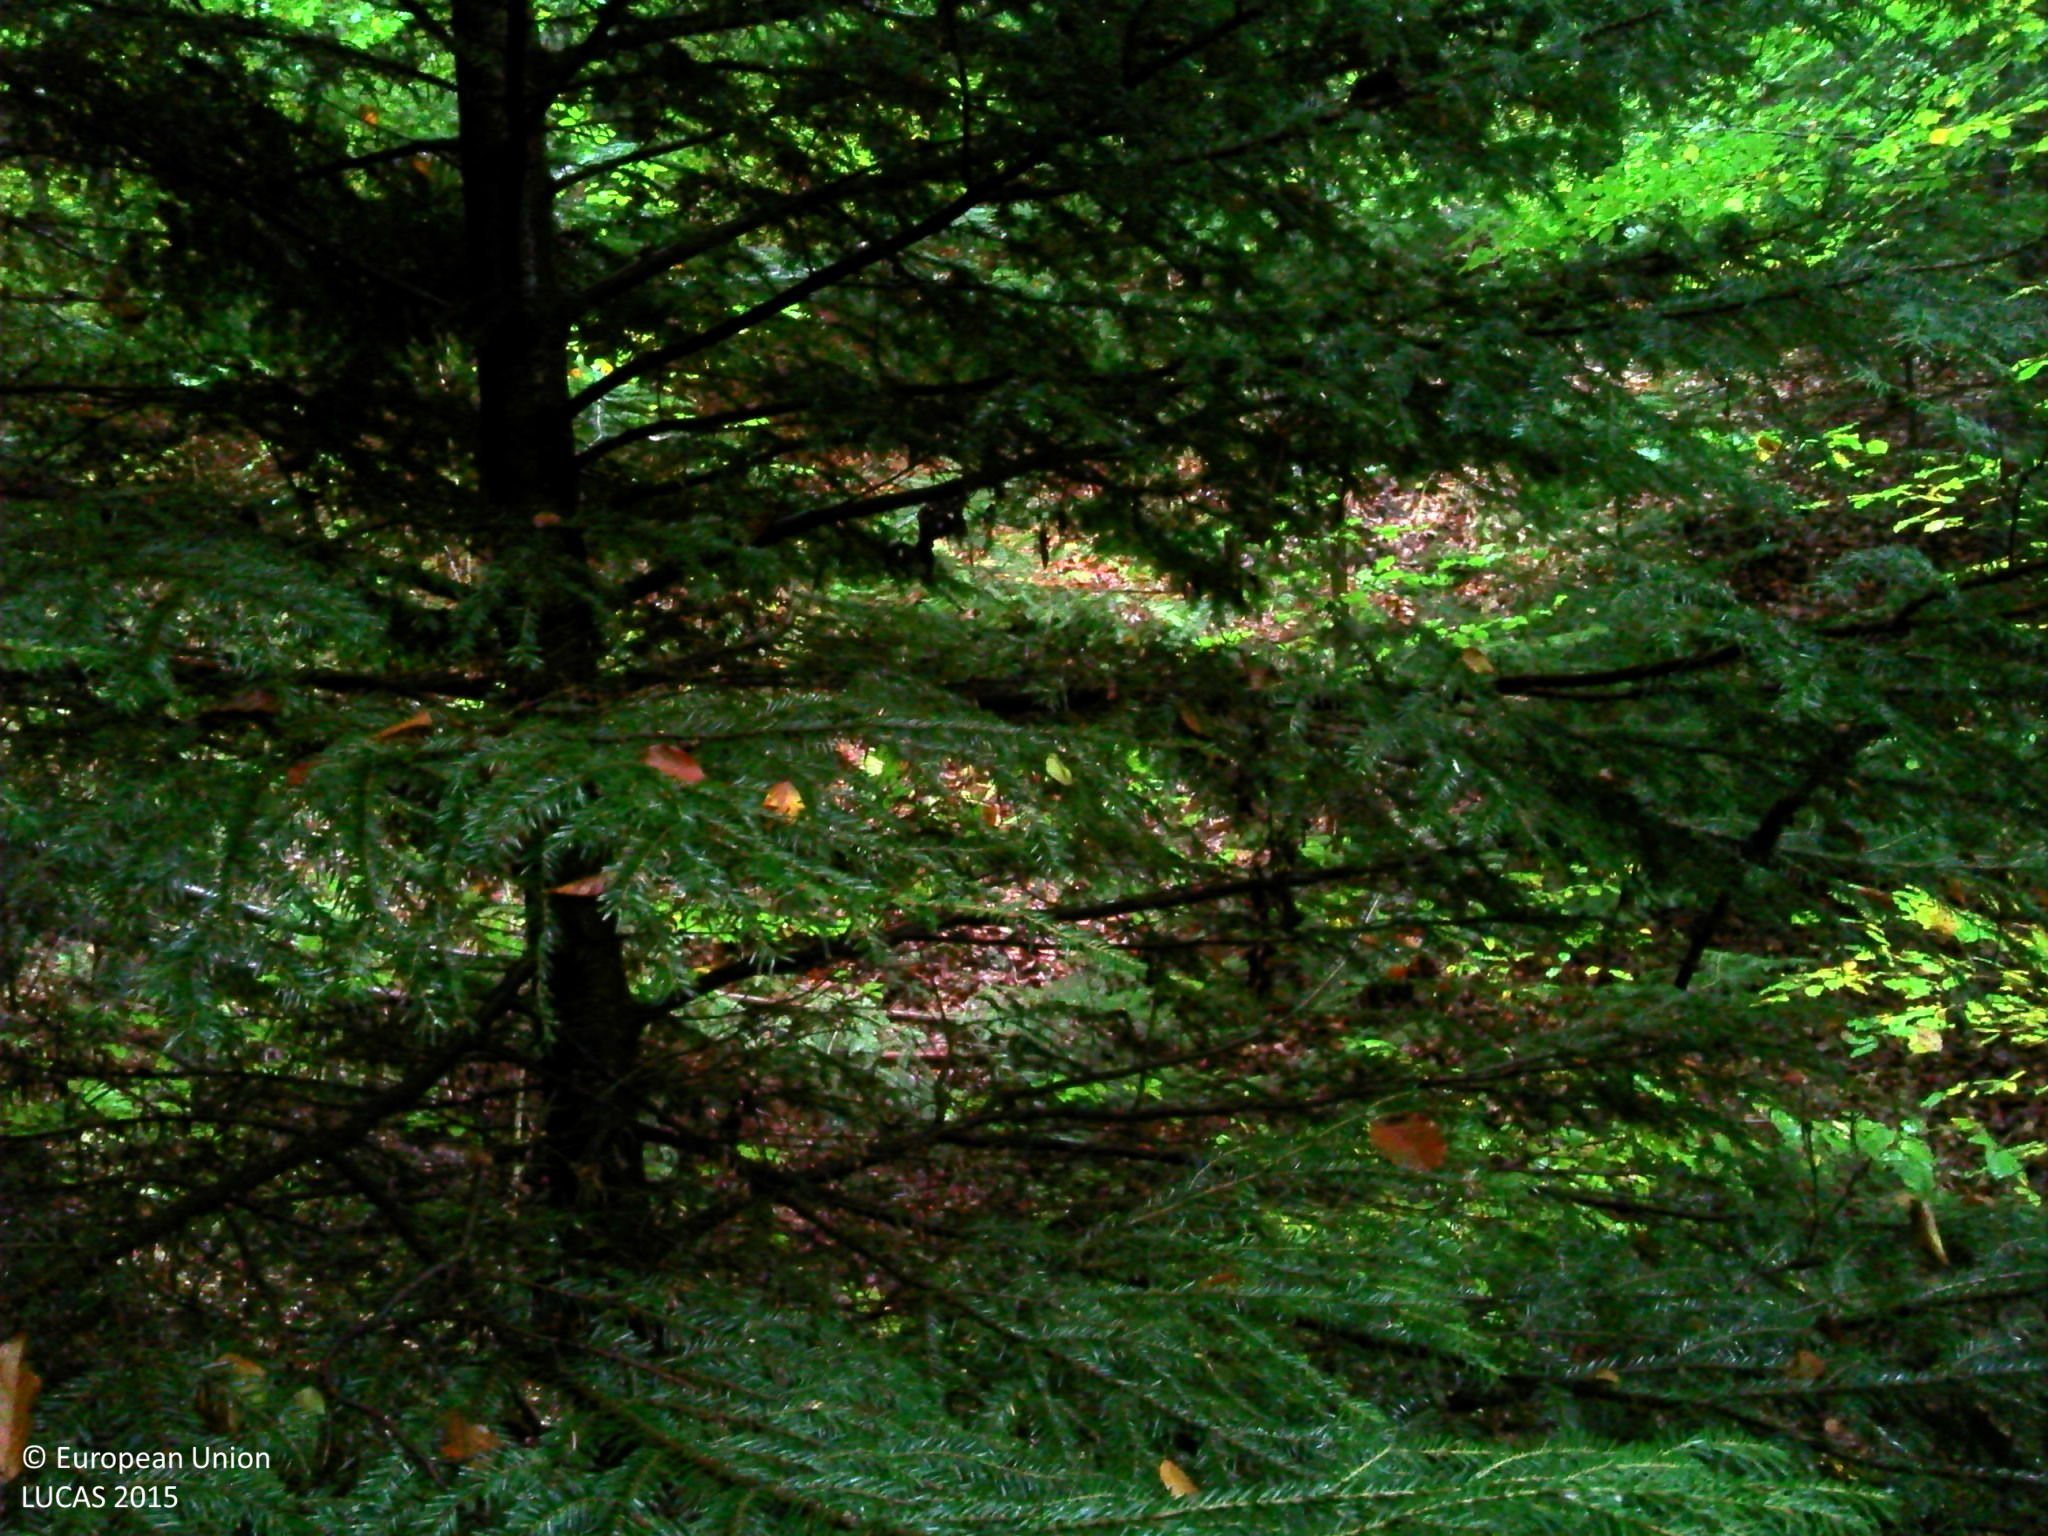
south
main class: Woodland
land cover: Broadleaved woodland
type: mountainous beech forest
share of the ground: > 75 %
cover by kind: broadleaved forest trees 80 %, coniferous forest trees 10 %, herbaceous plants 5 %, lichens and mosses 5 %
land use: Forestry
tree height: > 5 m
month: October
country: FR
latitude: 45.9108
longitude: 3.6712
